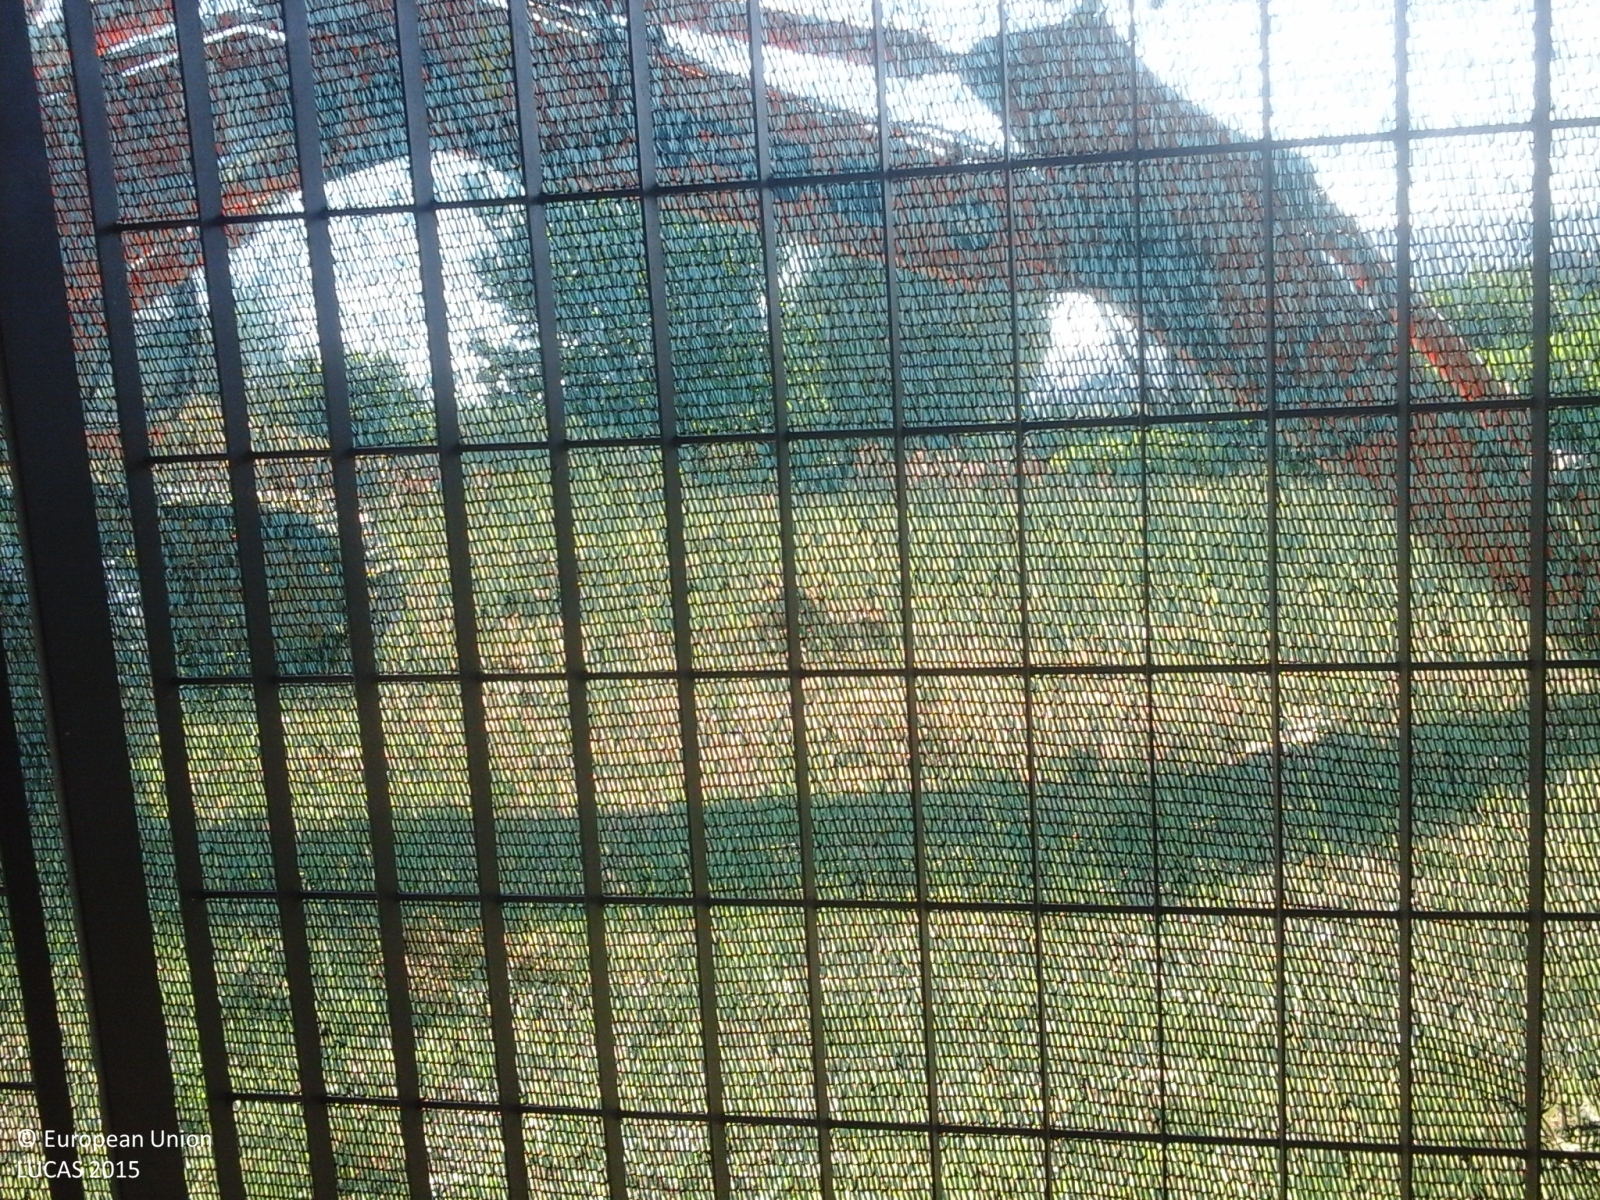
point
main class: Cropland
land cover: Olive groves
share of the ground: > 75 %
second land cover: Grassland without tree/shrub cover
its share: > 75 %
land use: Agriculture (excluding fallow land and kitchen gardens)
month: July
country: IT
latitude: 44.0148
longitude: 12.4517
